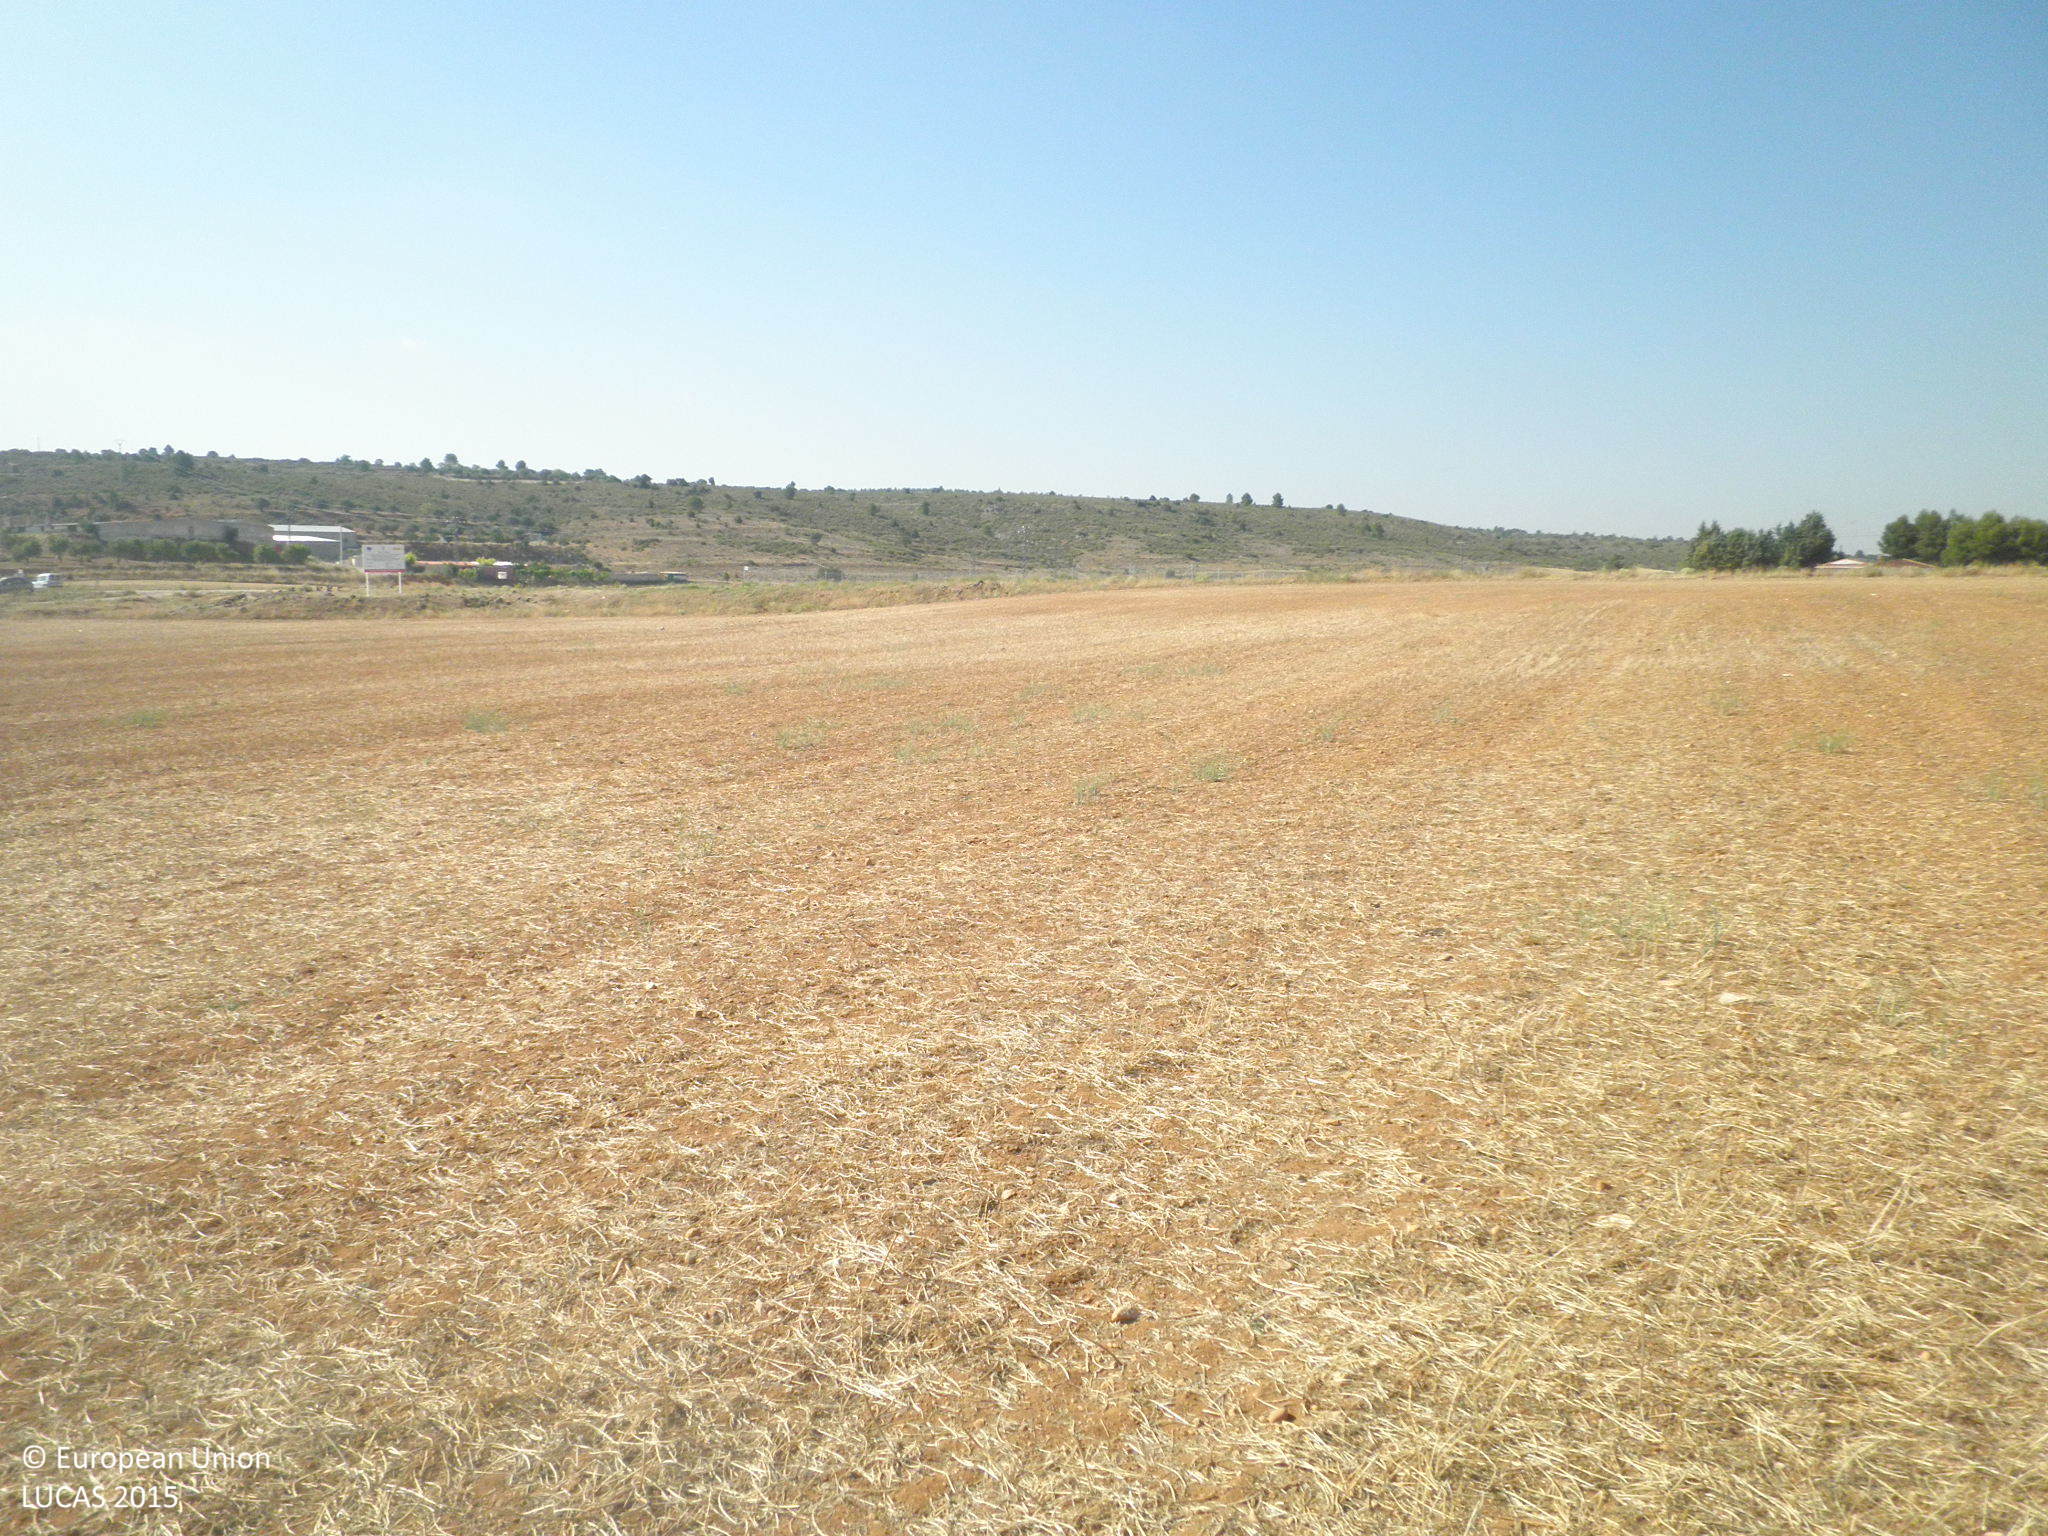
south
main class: Cropland
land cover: Dry pulses
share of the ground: < 10 %
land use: Agriculture (excluding fallow land and kitchen gardens)
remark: Harvested field
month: July
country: ES
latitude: 39.6095
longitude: -1.7827
